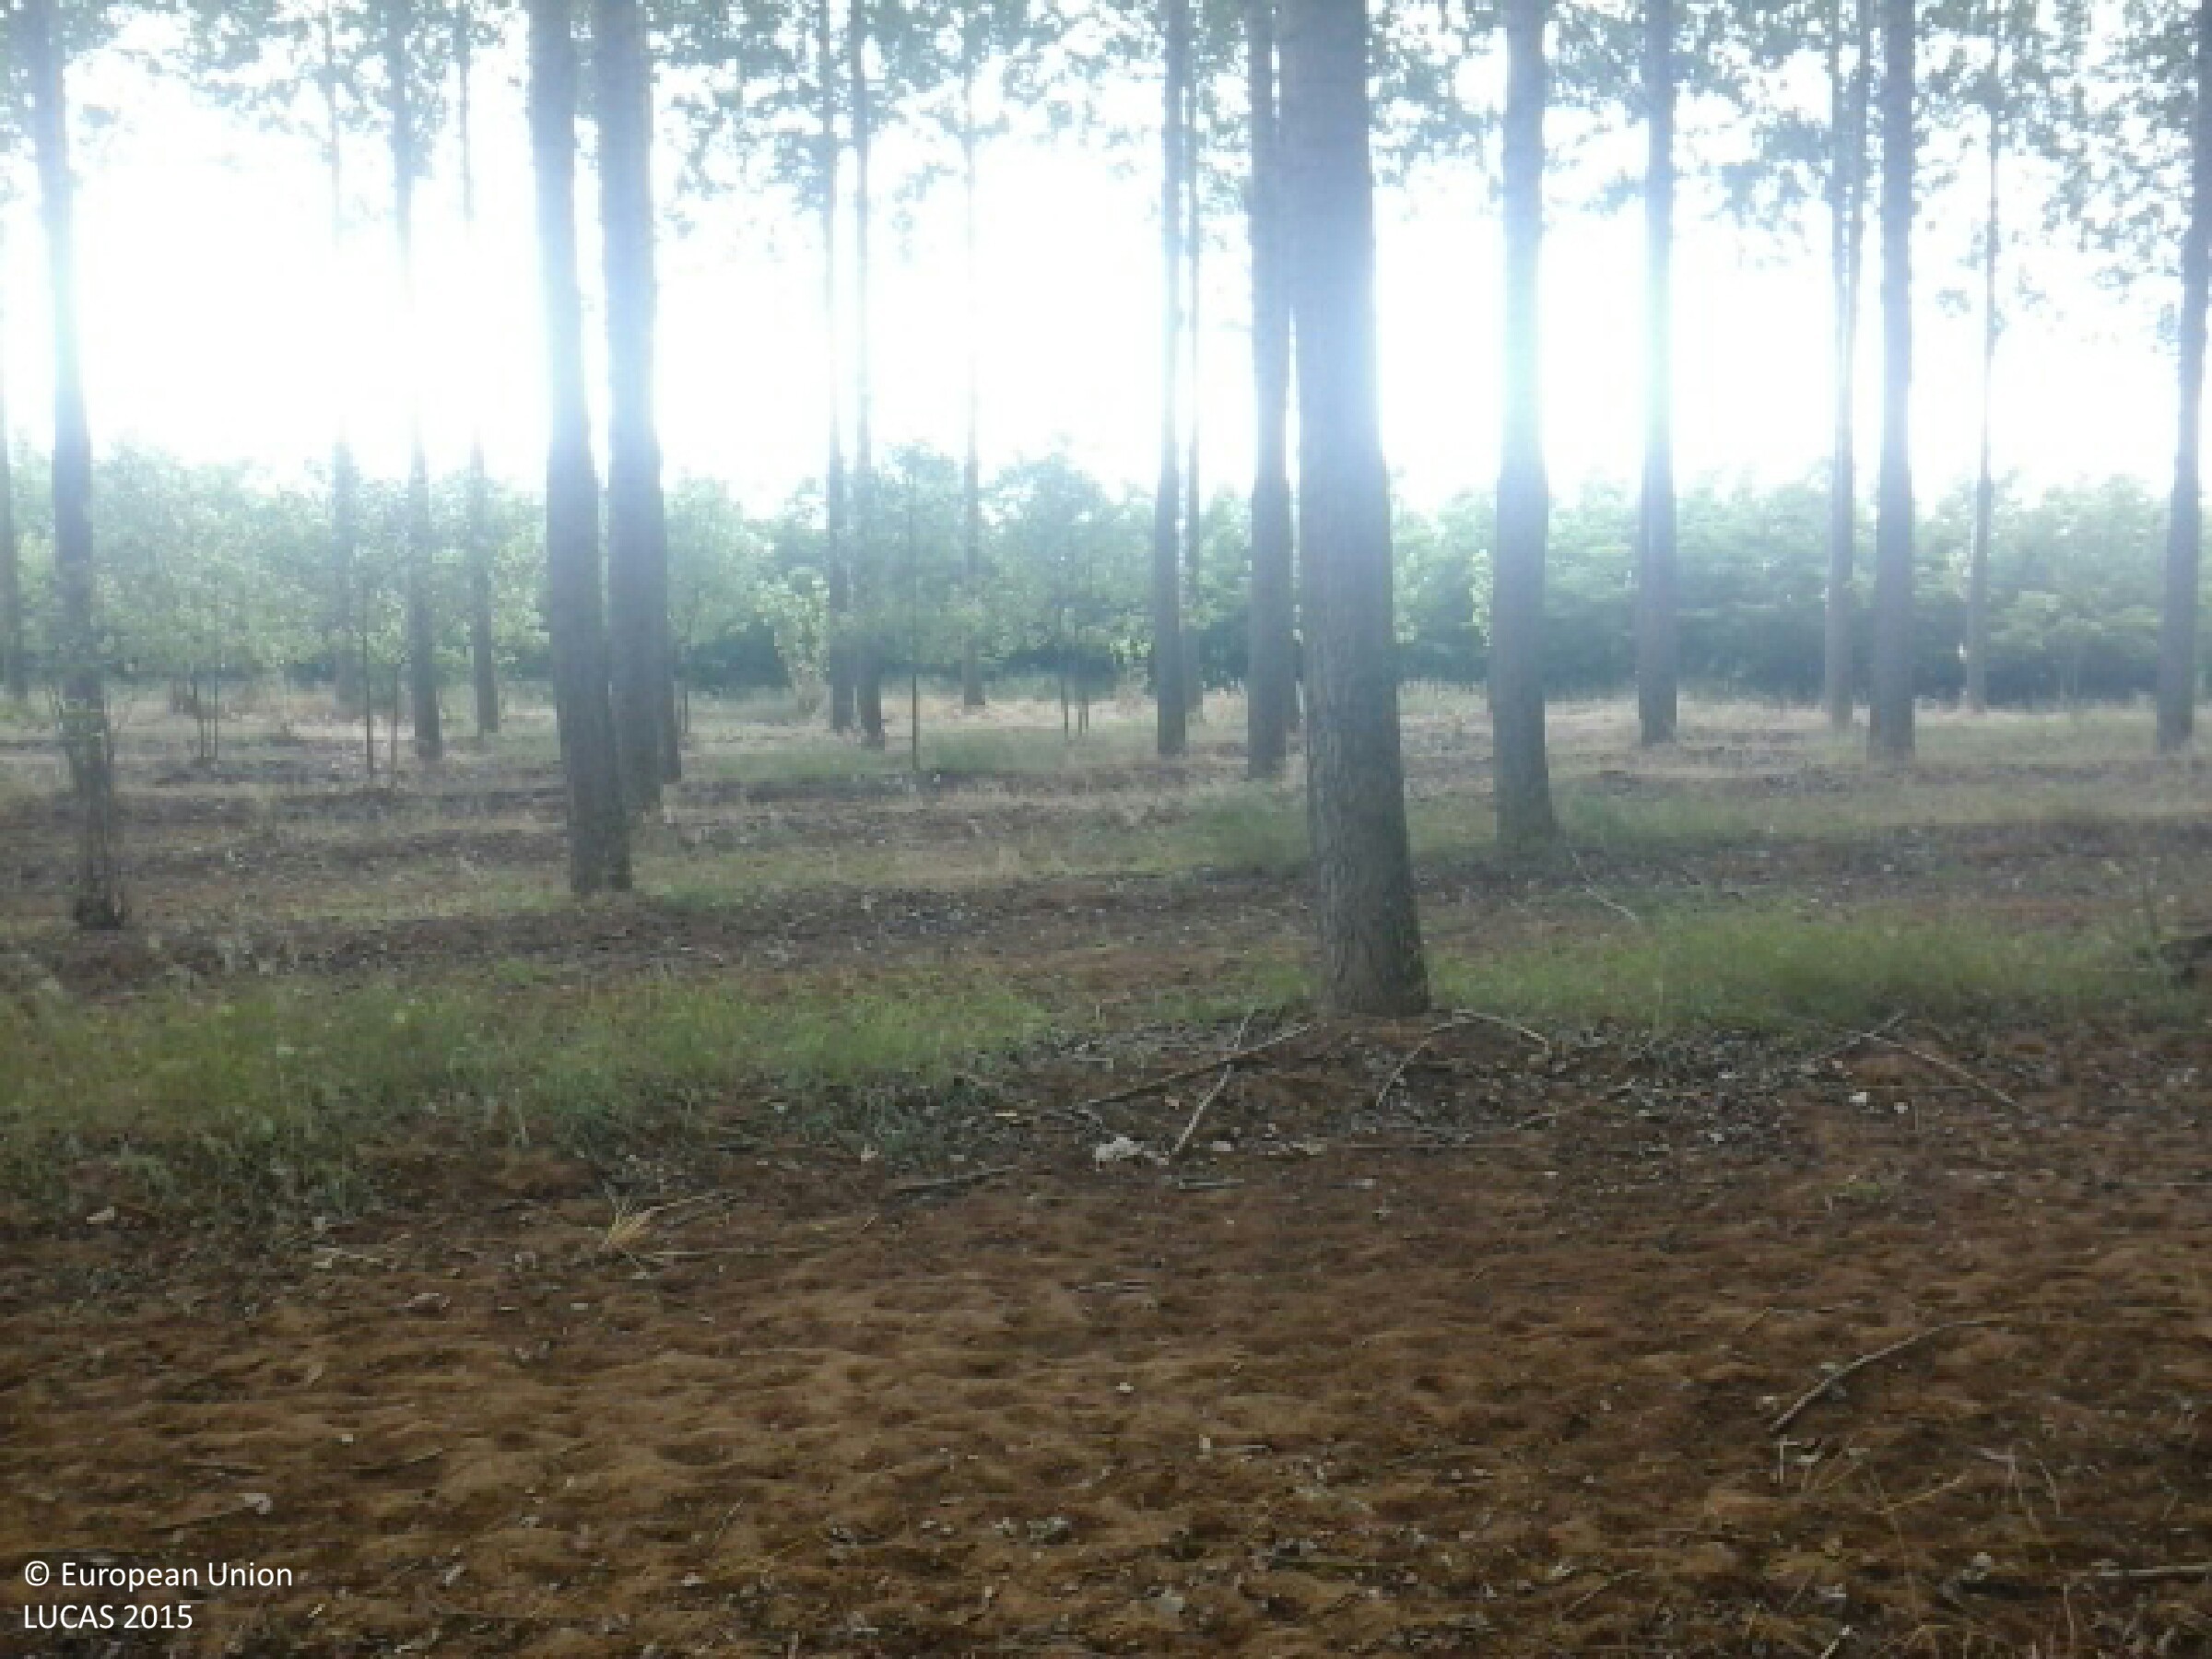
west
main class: Woodland
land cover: Broadleaved woodland
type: non-riverine alder, birch or aspen forest
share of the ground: > 75 %
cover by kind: broadleaved forest trees 100 %
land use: Forestry
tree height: > 5 m
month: June
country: HU
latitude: 48.0735
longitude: 22.1746
